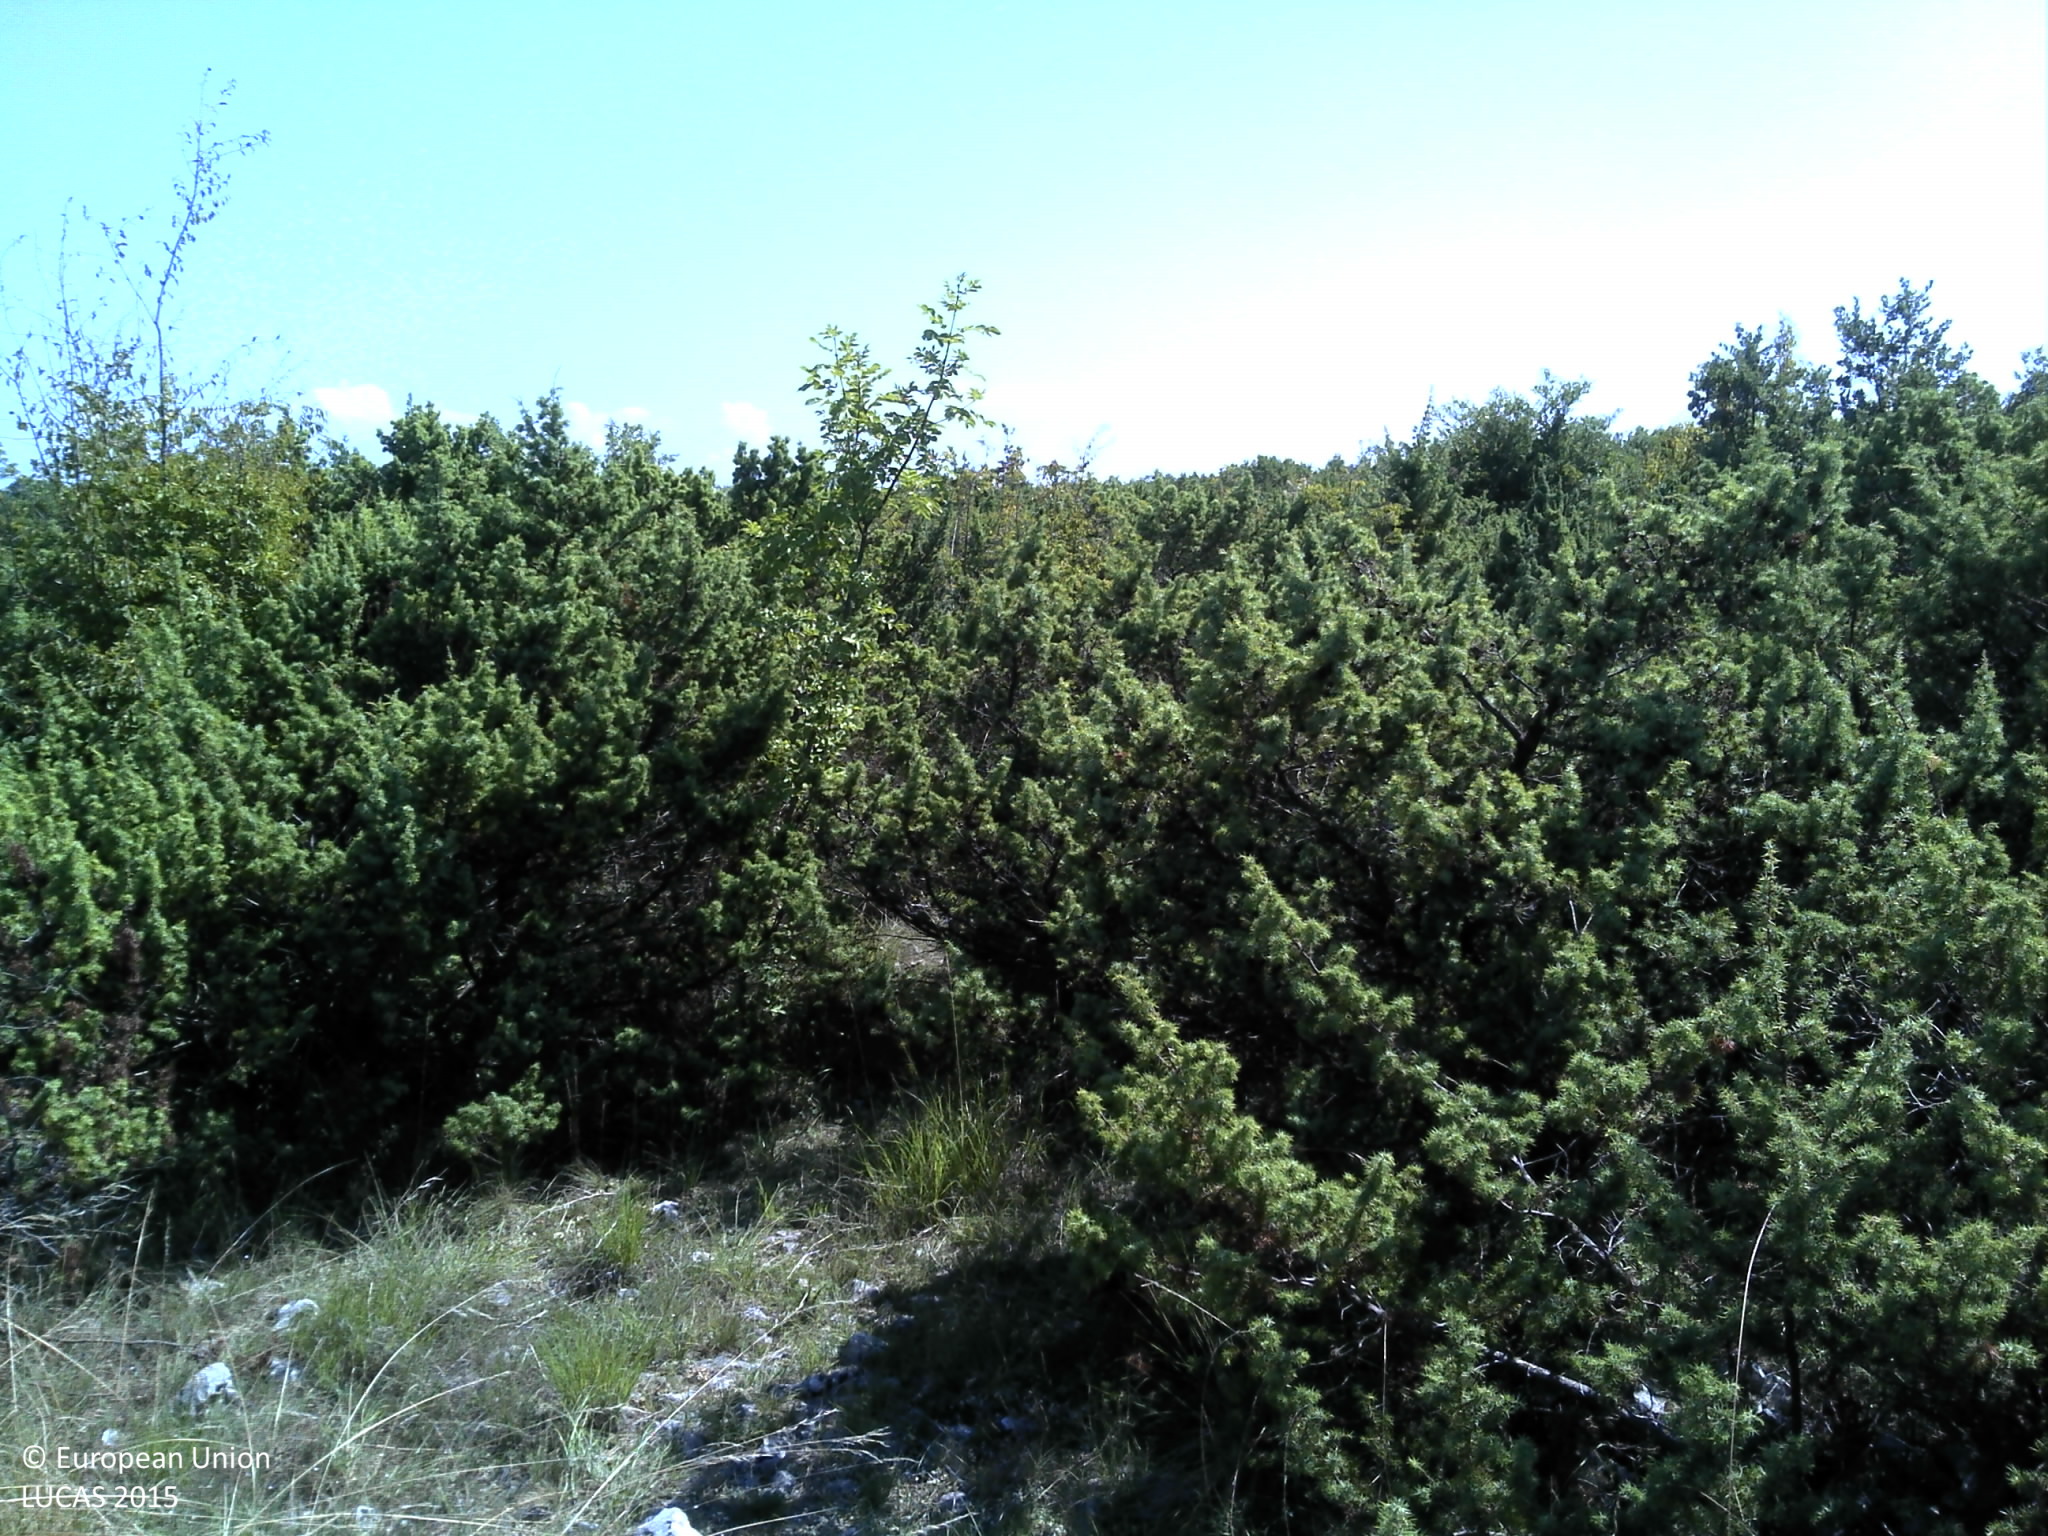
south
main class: Shrubland
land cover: Shrubland with sparse tree cover
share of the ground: > 75 %
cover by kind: shrubs 80 %, consolidated bare surface 10 %, coniferous forest trees 5 %, herbaceous plants 5 %
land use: Semi-natural and natural areas not in use
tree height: < 5 m
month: August
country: HR
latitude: 43.9996
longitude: 15.6161
